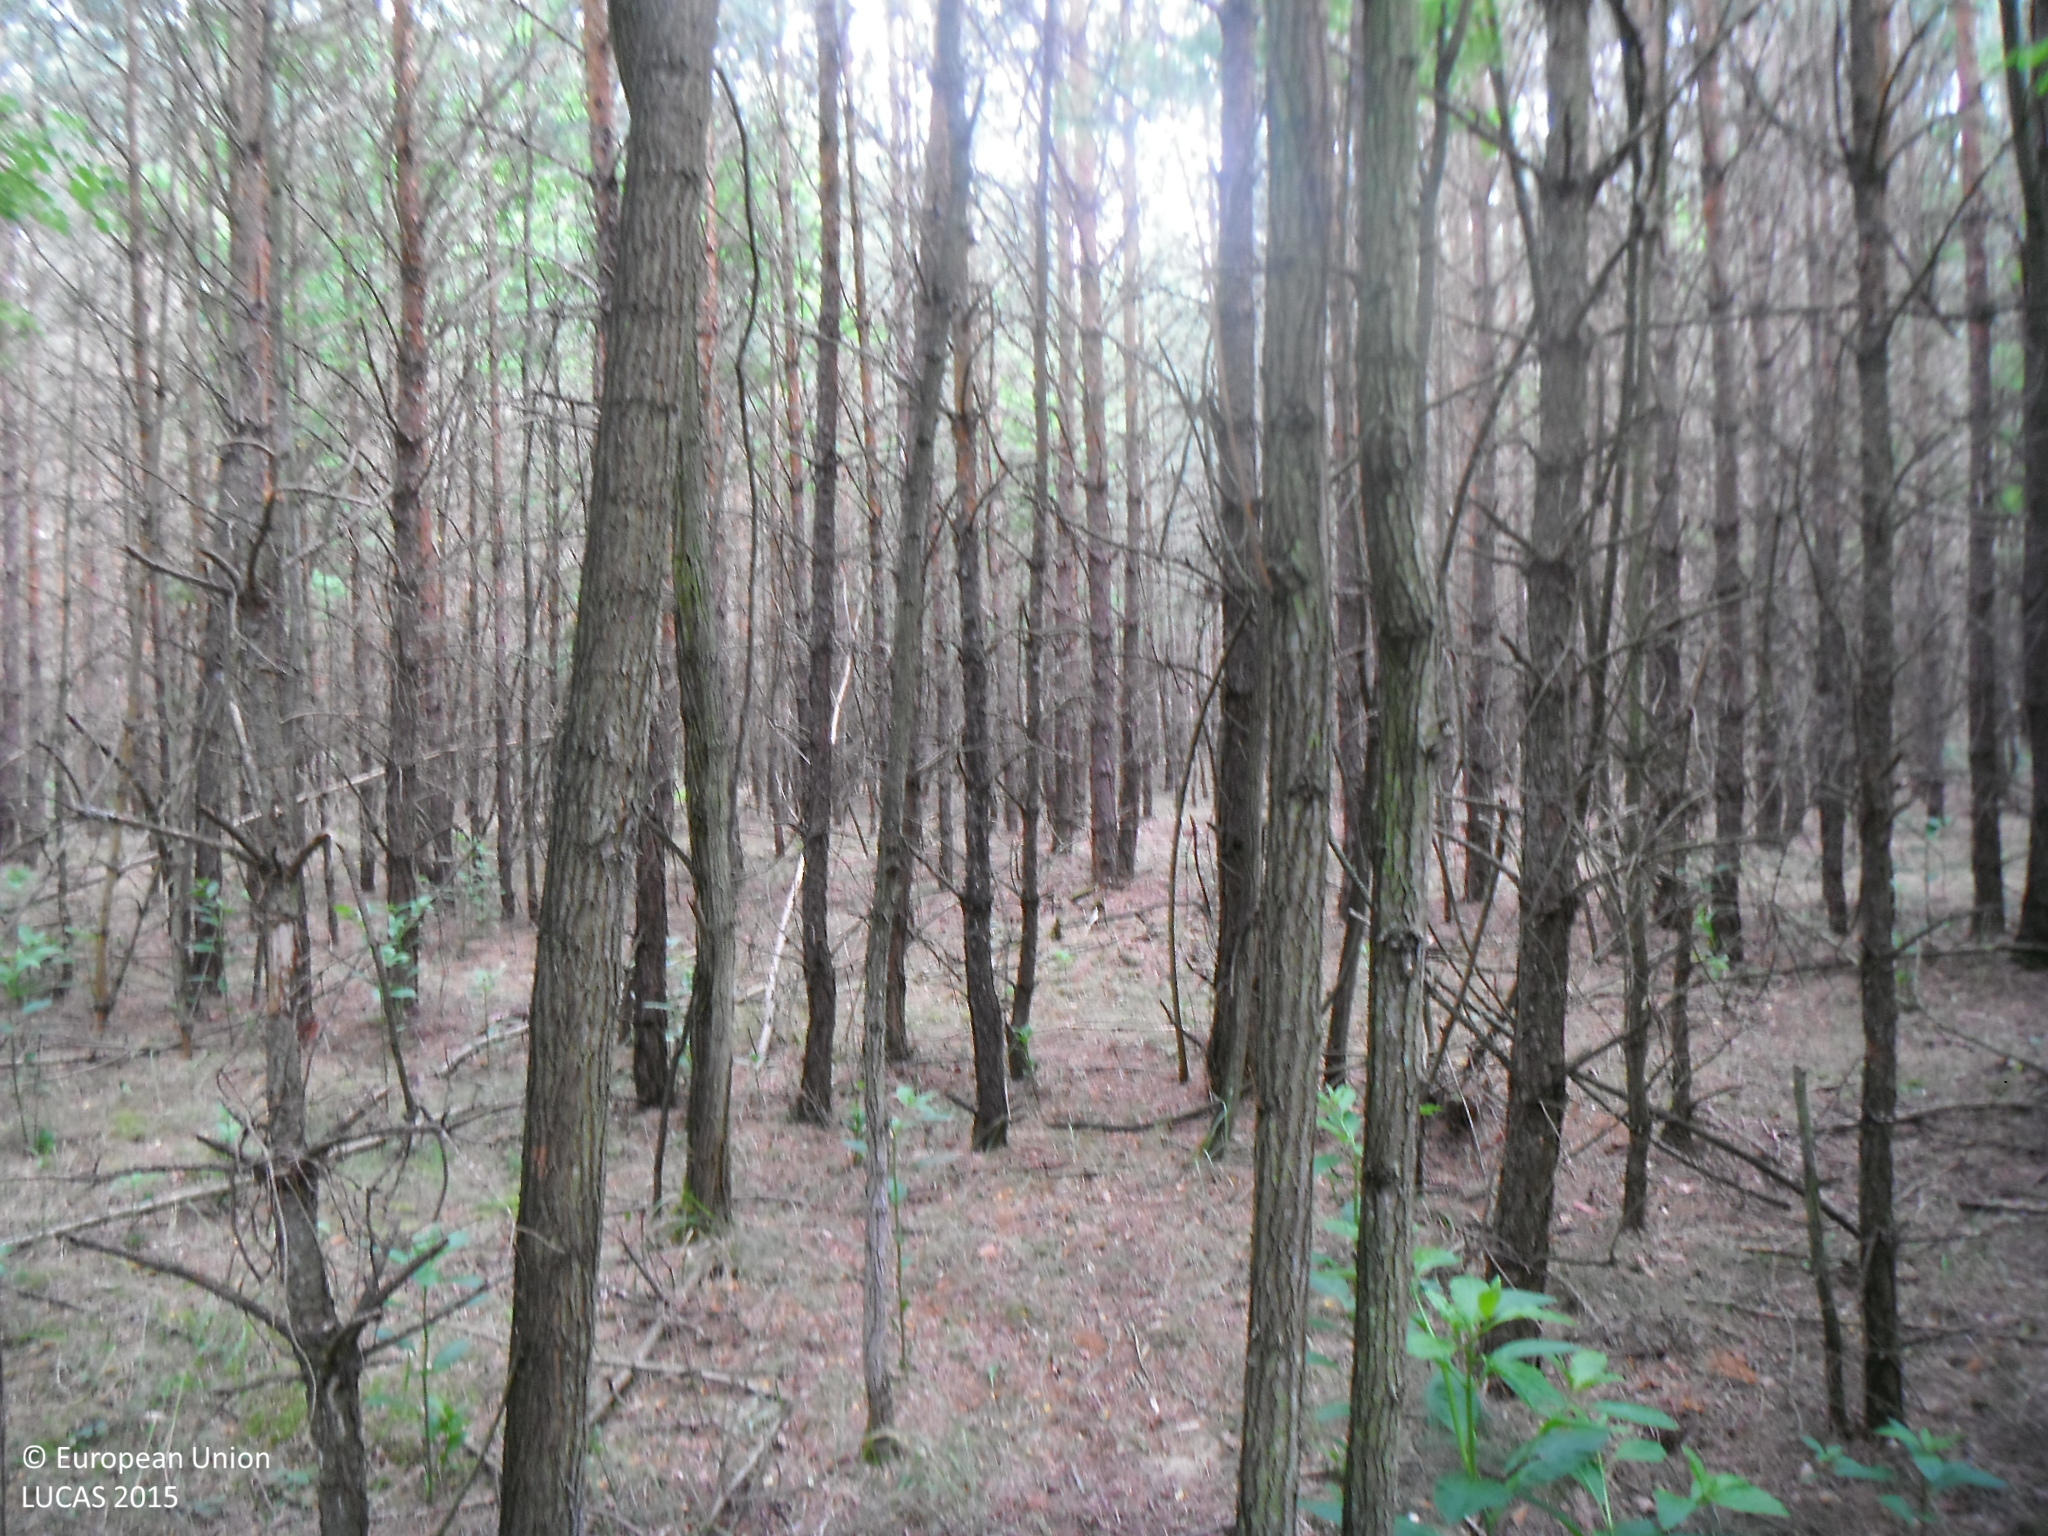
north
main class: Woodland
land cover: Pine dominated mixed woodland
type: hemiboreal forest and nemoral coniferous forest and mixed broadleaved-coniferous forest
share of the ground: > 75 %
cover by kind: coniferous forest trees 50 %, broadleaved forest trees 45 %, herbaceous plants 5 %
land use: Forestry
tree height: > 5 m
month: June
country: SK
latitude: 48.6229
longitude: 17.1587
